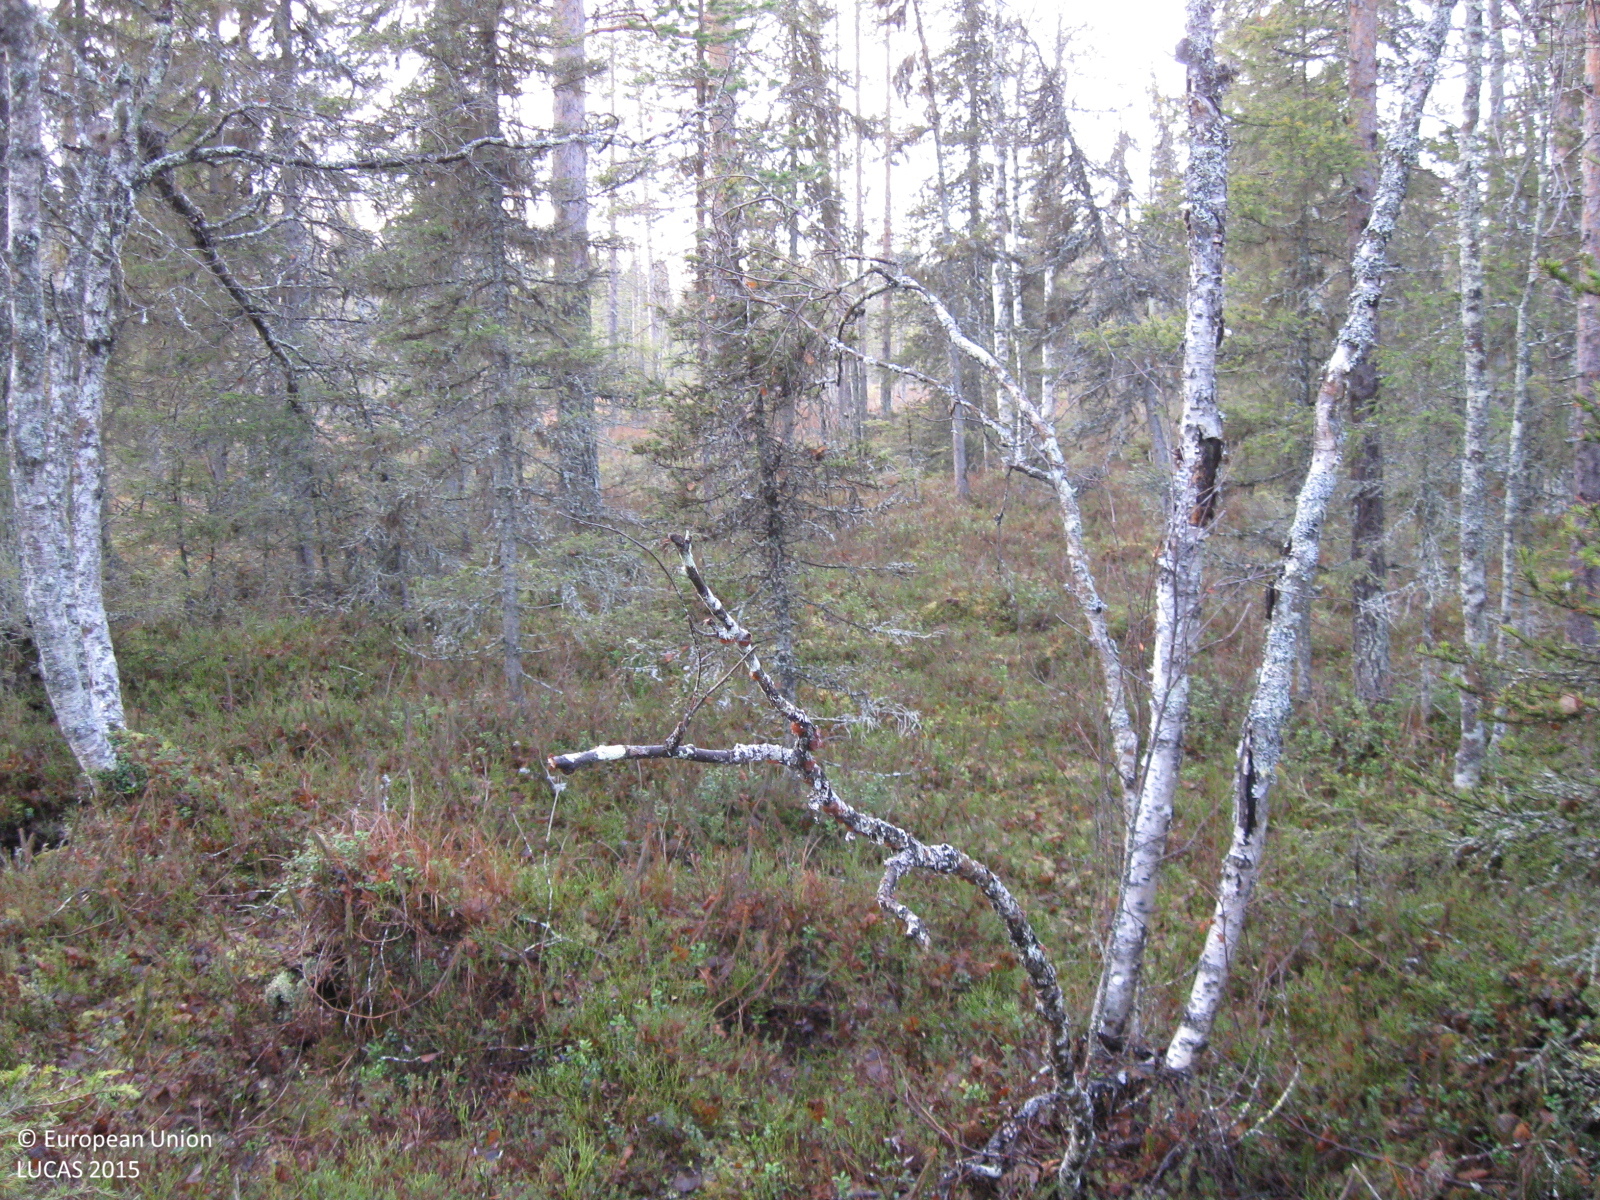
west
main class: Woodland
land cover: Other coniferous woodland
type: mire and swamp forests
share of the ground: 50 - 75 %
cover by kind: coniferous forest trees 60 %, shrubs 20 %, broadleaved forest trees 10 %, herbaceous plants 5 %, lichens and mosses 5 %
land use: Forestry
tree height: > 5 m
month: October
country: SE
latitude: 66.4586
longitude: 21.3824
